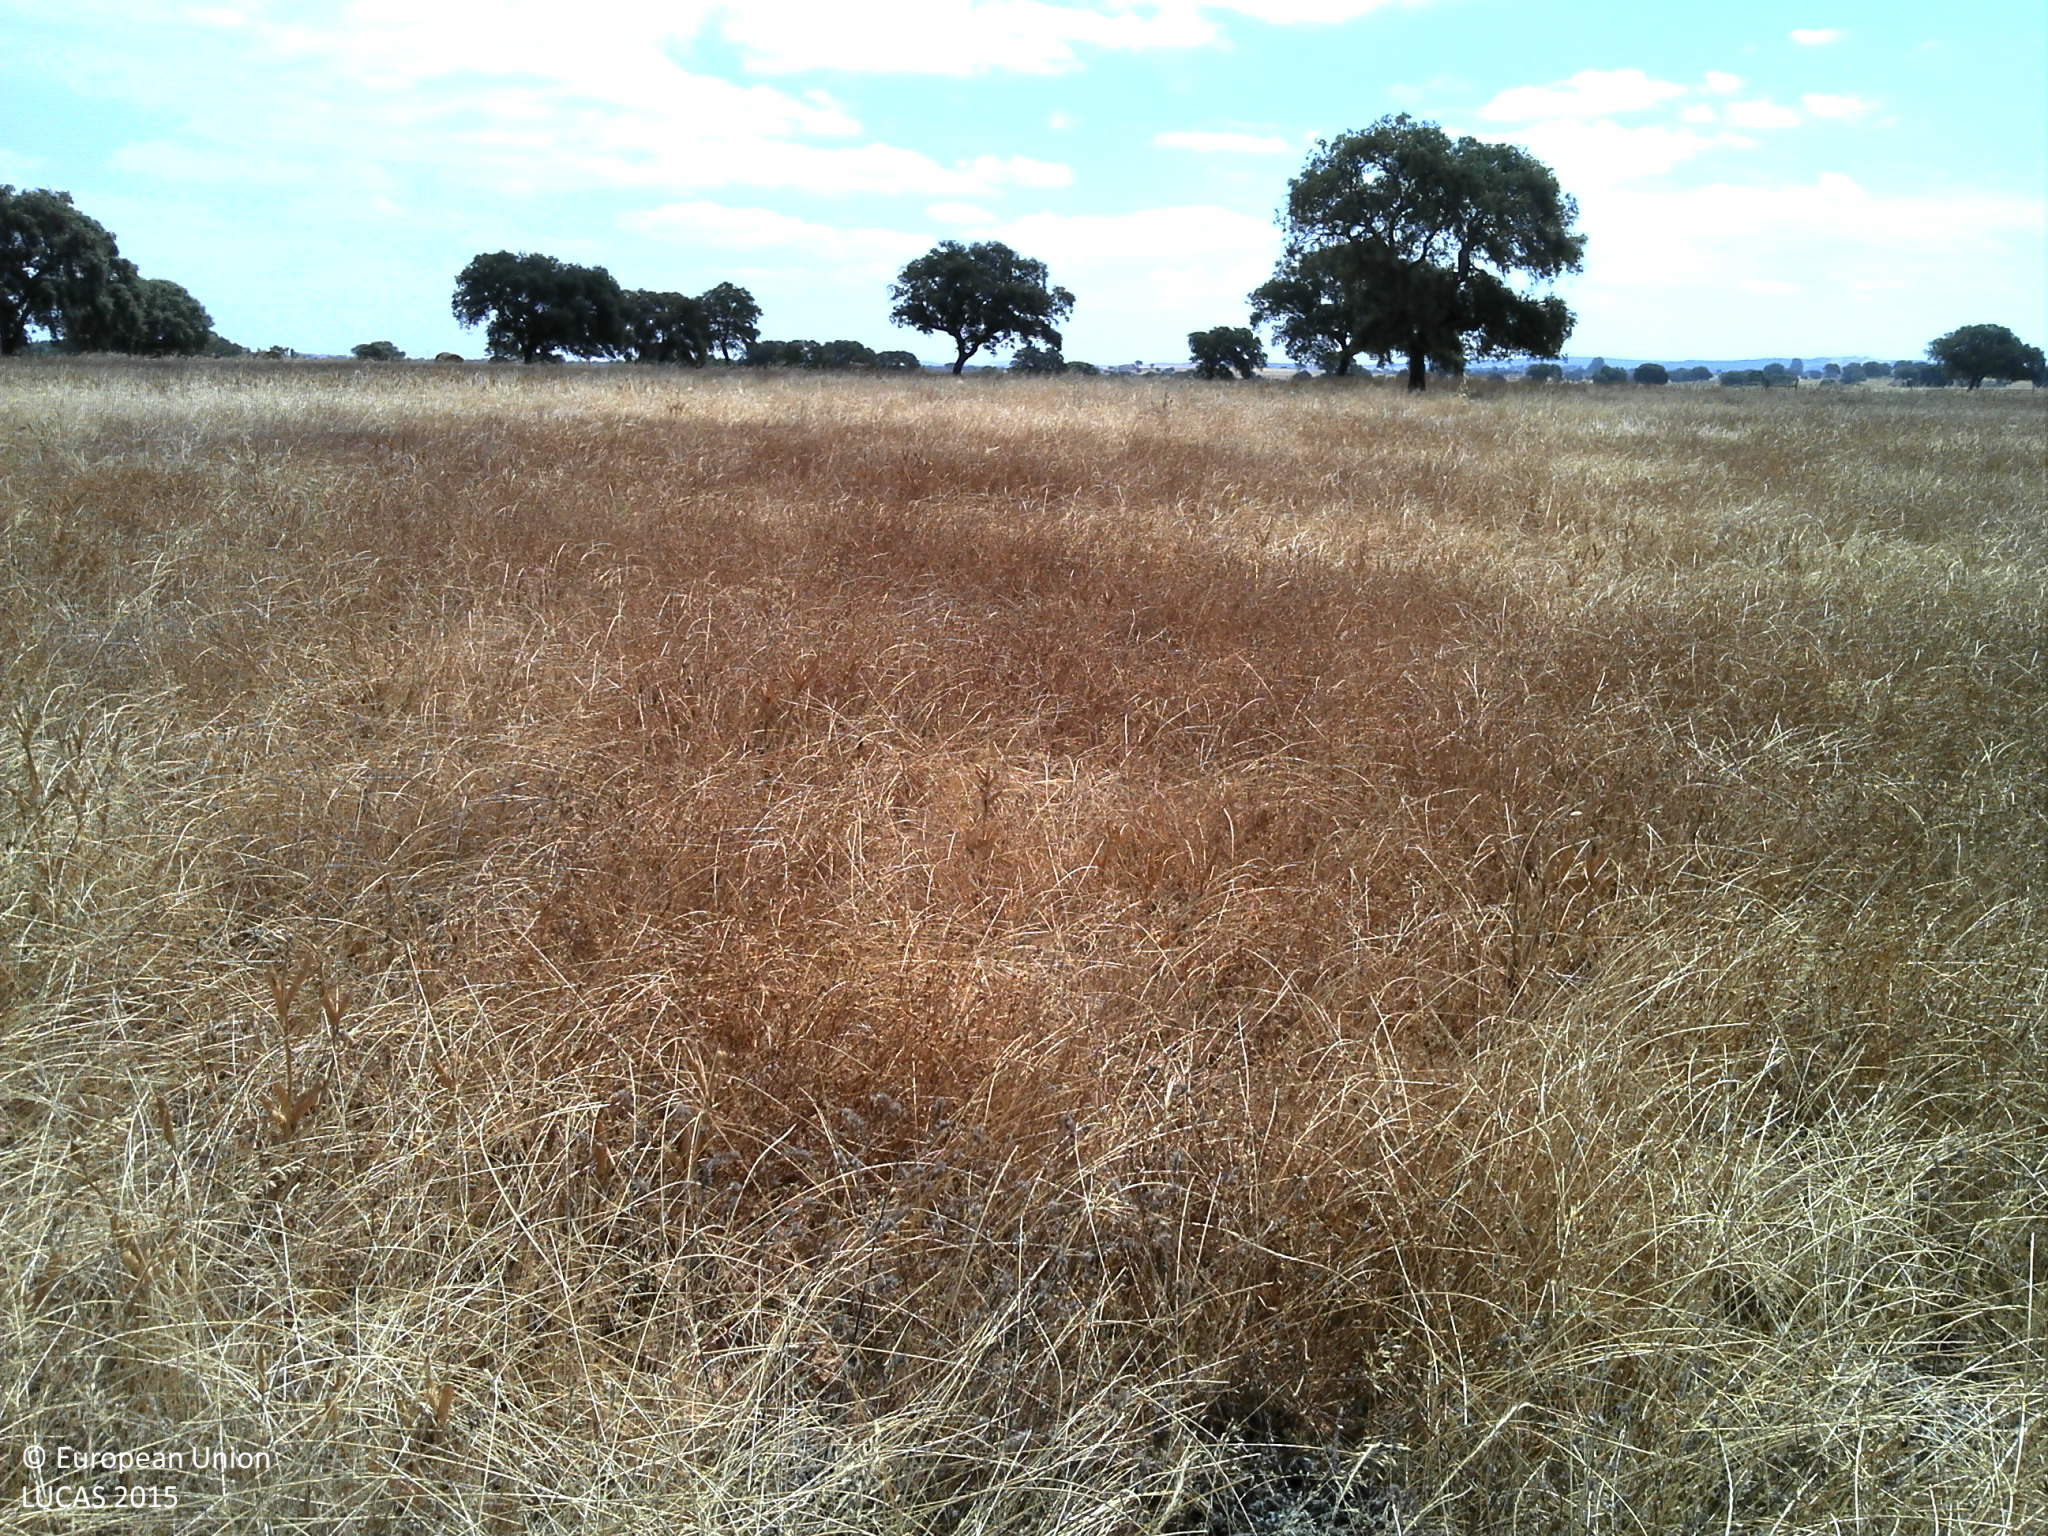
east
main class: Grassland
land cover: Grassland without tree/shrub cover
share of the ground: > 75 %
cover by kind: herbaceous plants 90 %, unconsolidated bare surface 10 %
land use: Agriculture (excluding fallow land and kitchen gardens)
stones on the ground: < 10 %
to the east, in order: Grassland without tree/shrub cover; Tracks; Fences; Spontaneously vegetated surfaces
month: June
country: PT
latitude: 37.8410
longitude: -8.3189
